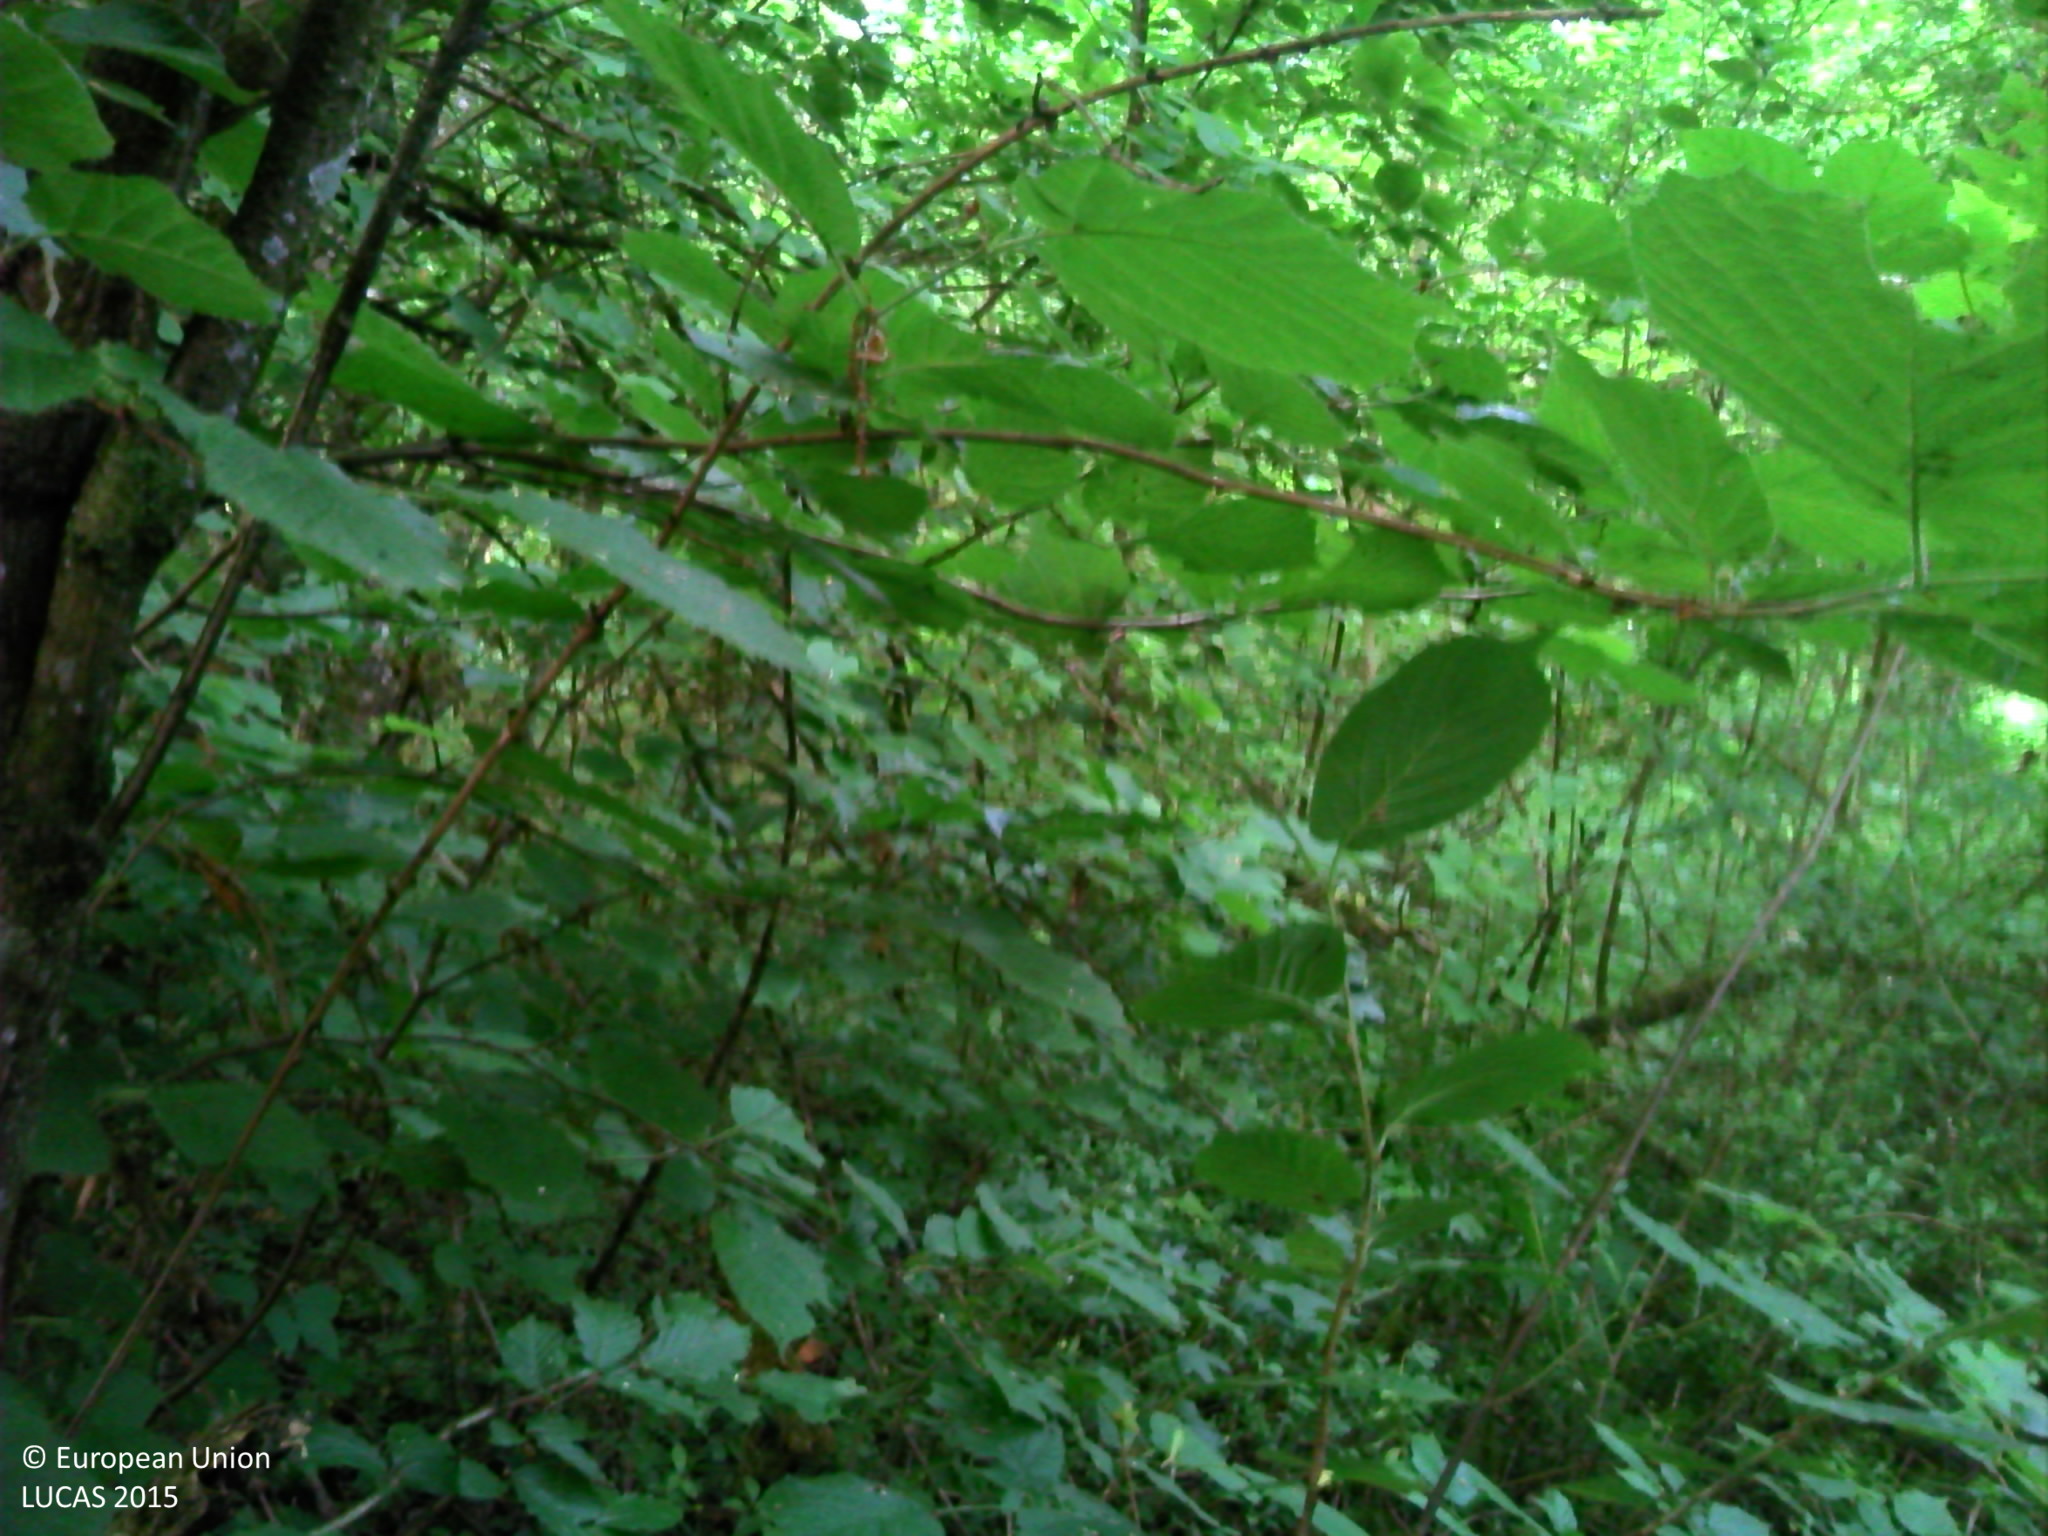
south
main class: Woodland
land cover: Broadleaved woodland
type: beech forest
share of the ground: > 75 %
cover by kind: broadleaved forest trees 90 %, herbaceous plants 10 %
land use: Forestry
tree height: > 5 m
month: June
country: FR
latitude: 47.7428
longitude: 6.1735
